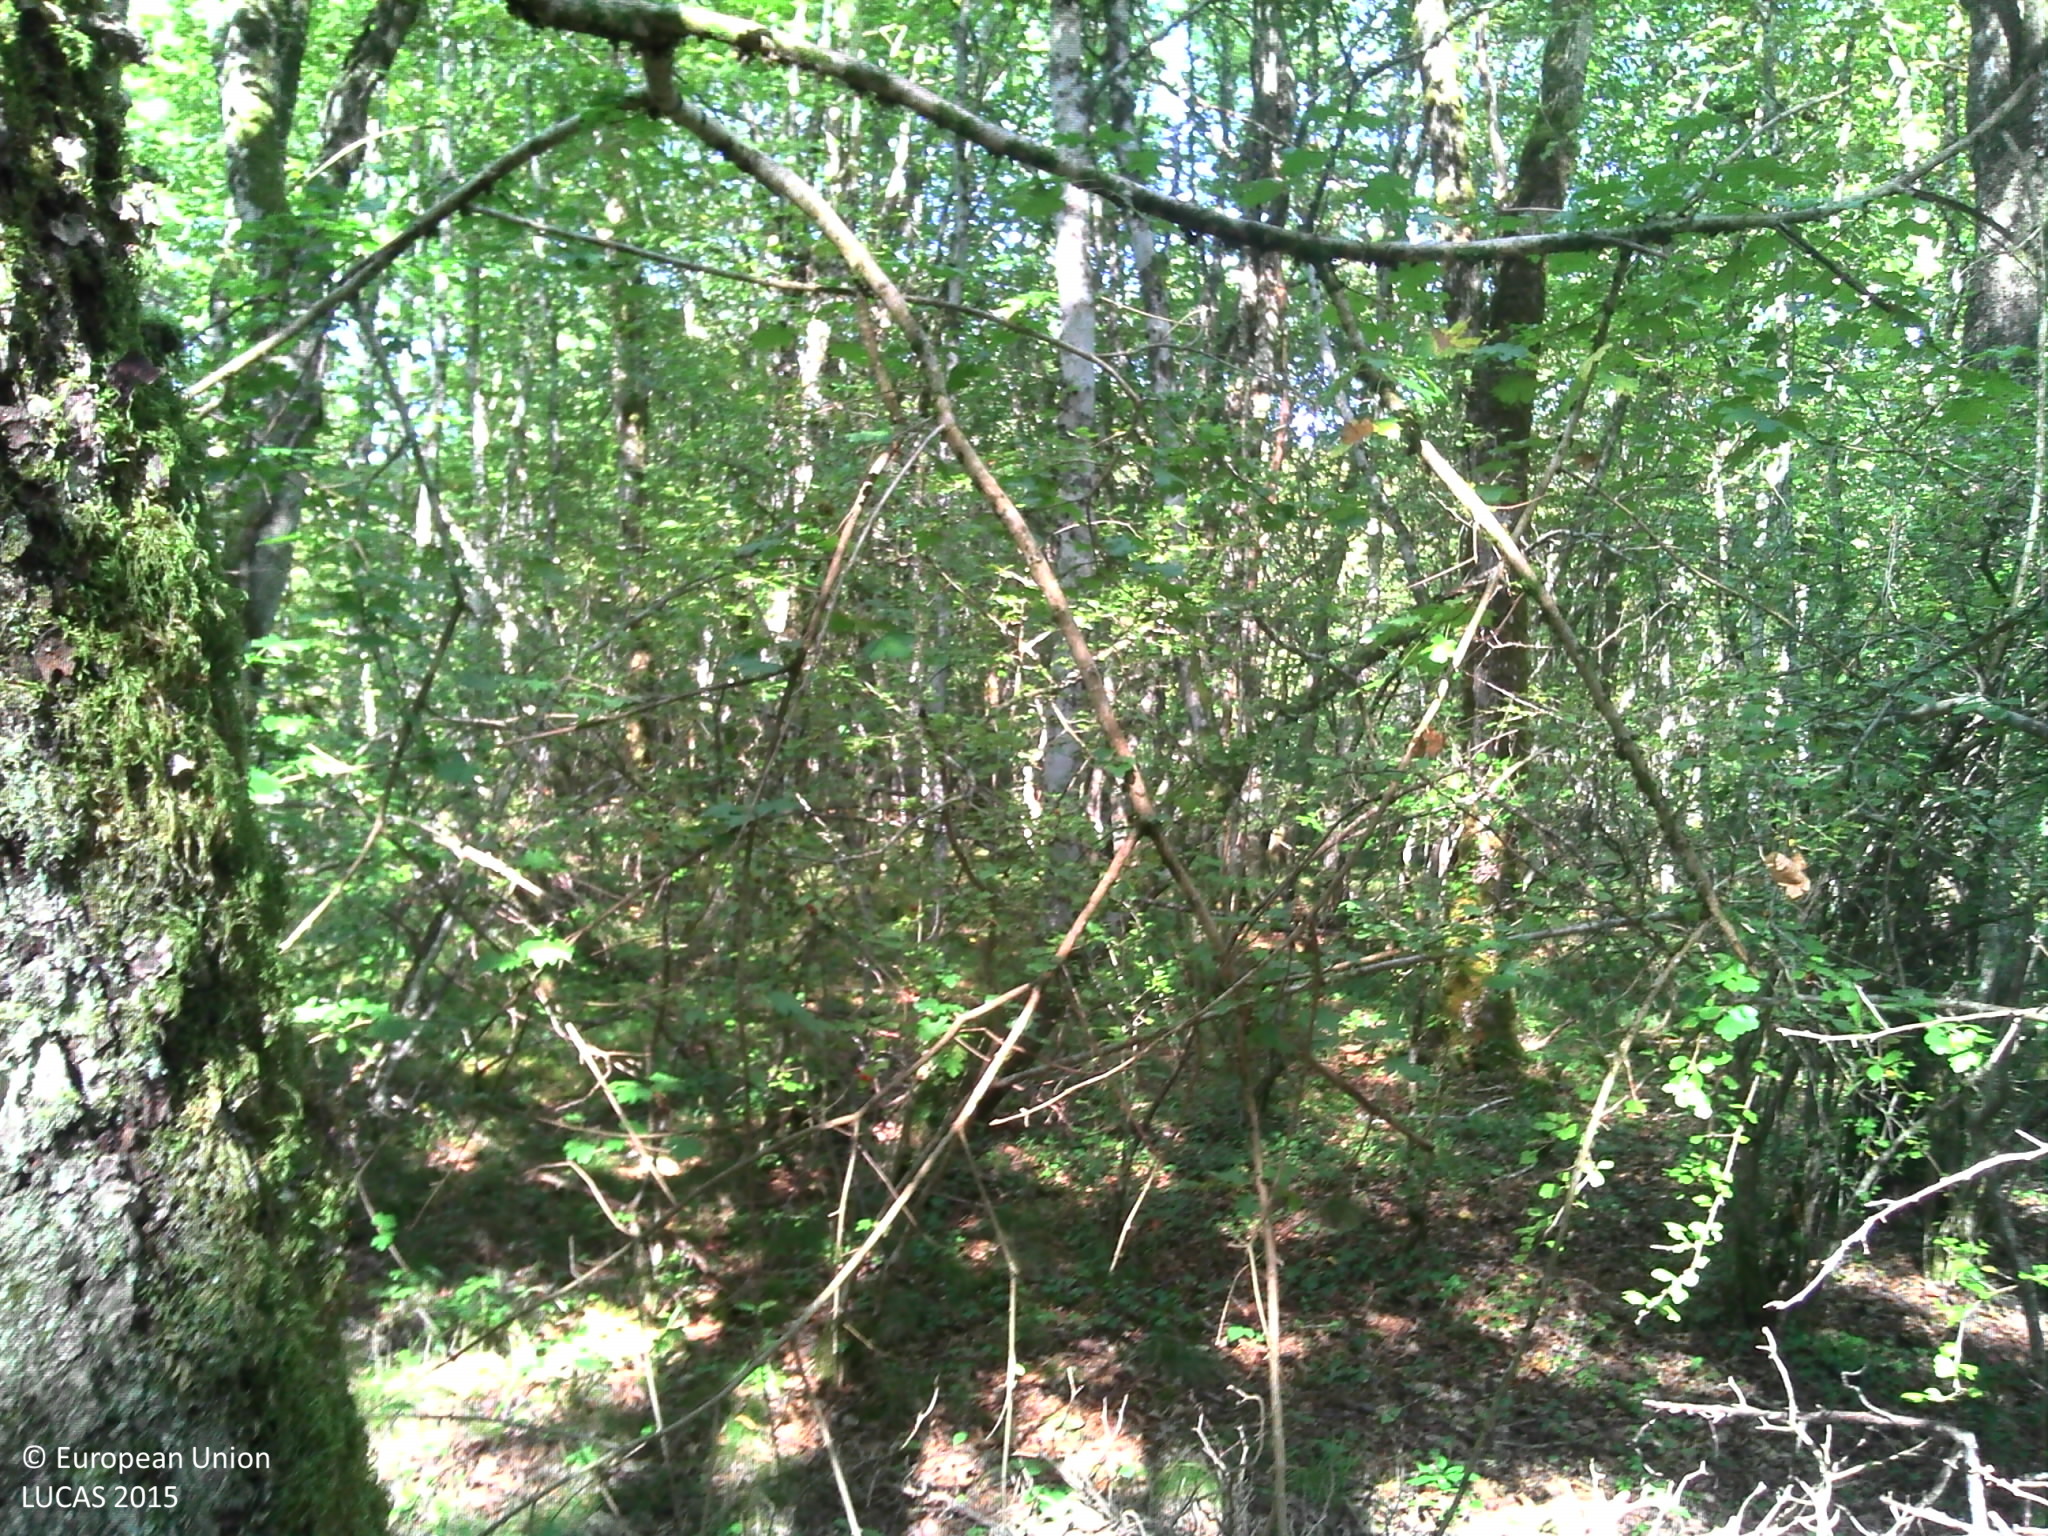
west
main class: Woodland
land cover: Broadleaved woodland
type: mesophytic deciduous forest
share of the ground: > 75 %
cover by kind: broadleaved forest trees 80 %, shrubs 10 %, herbaceous plants 10 %
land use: Forestry
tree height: > 5 m
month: August
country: FR
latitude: 47.2010
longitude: 4.8389
